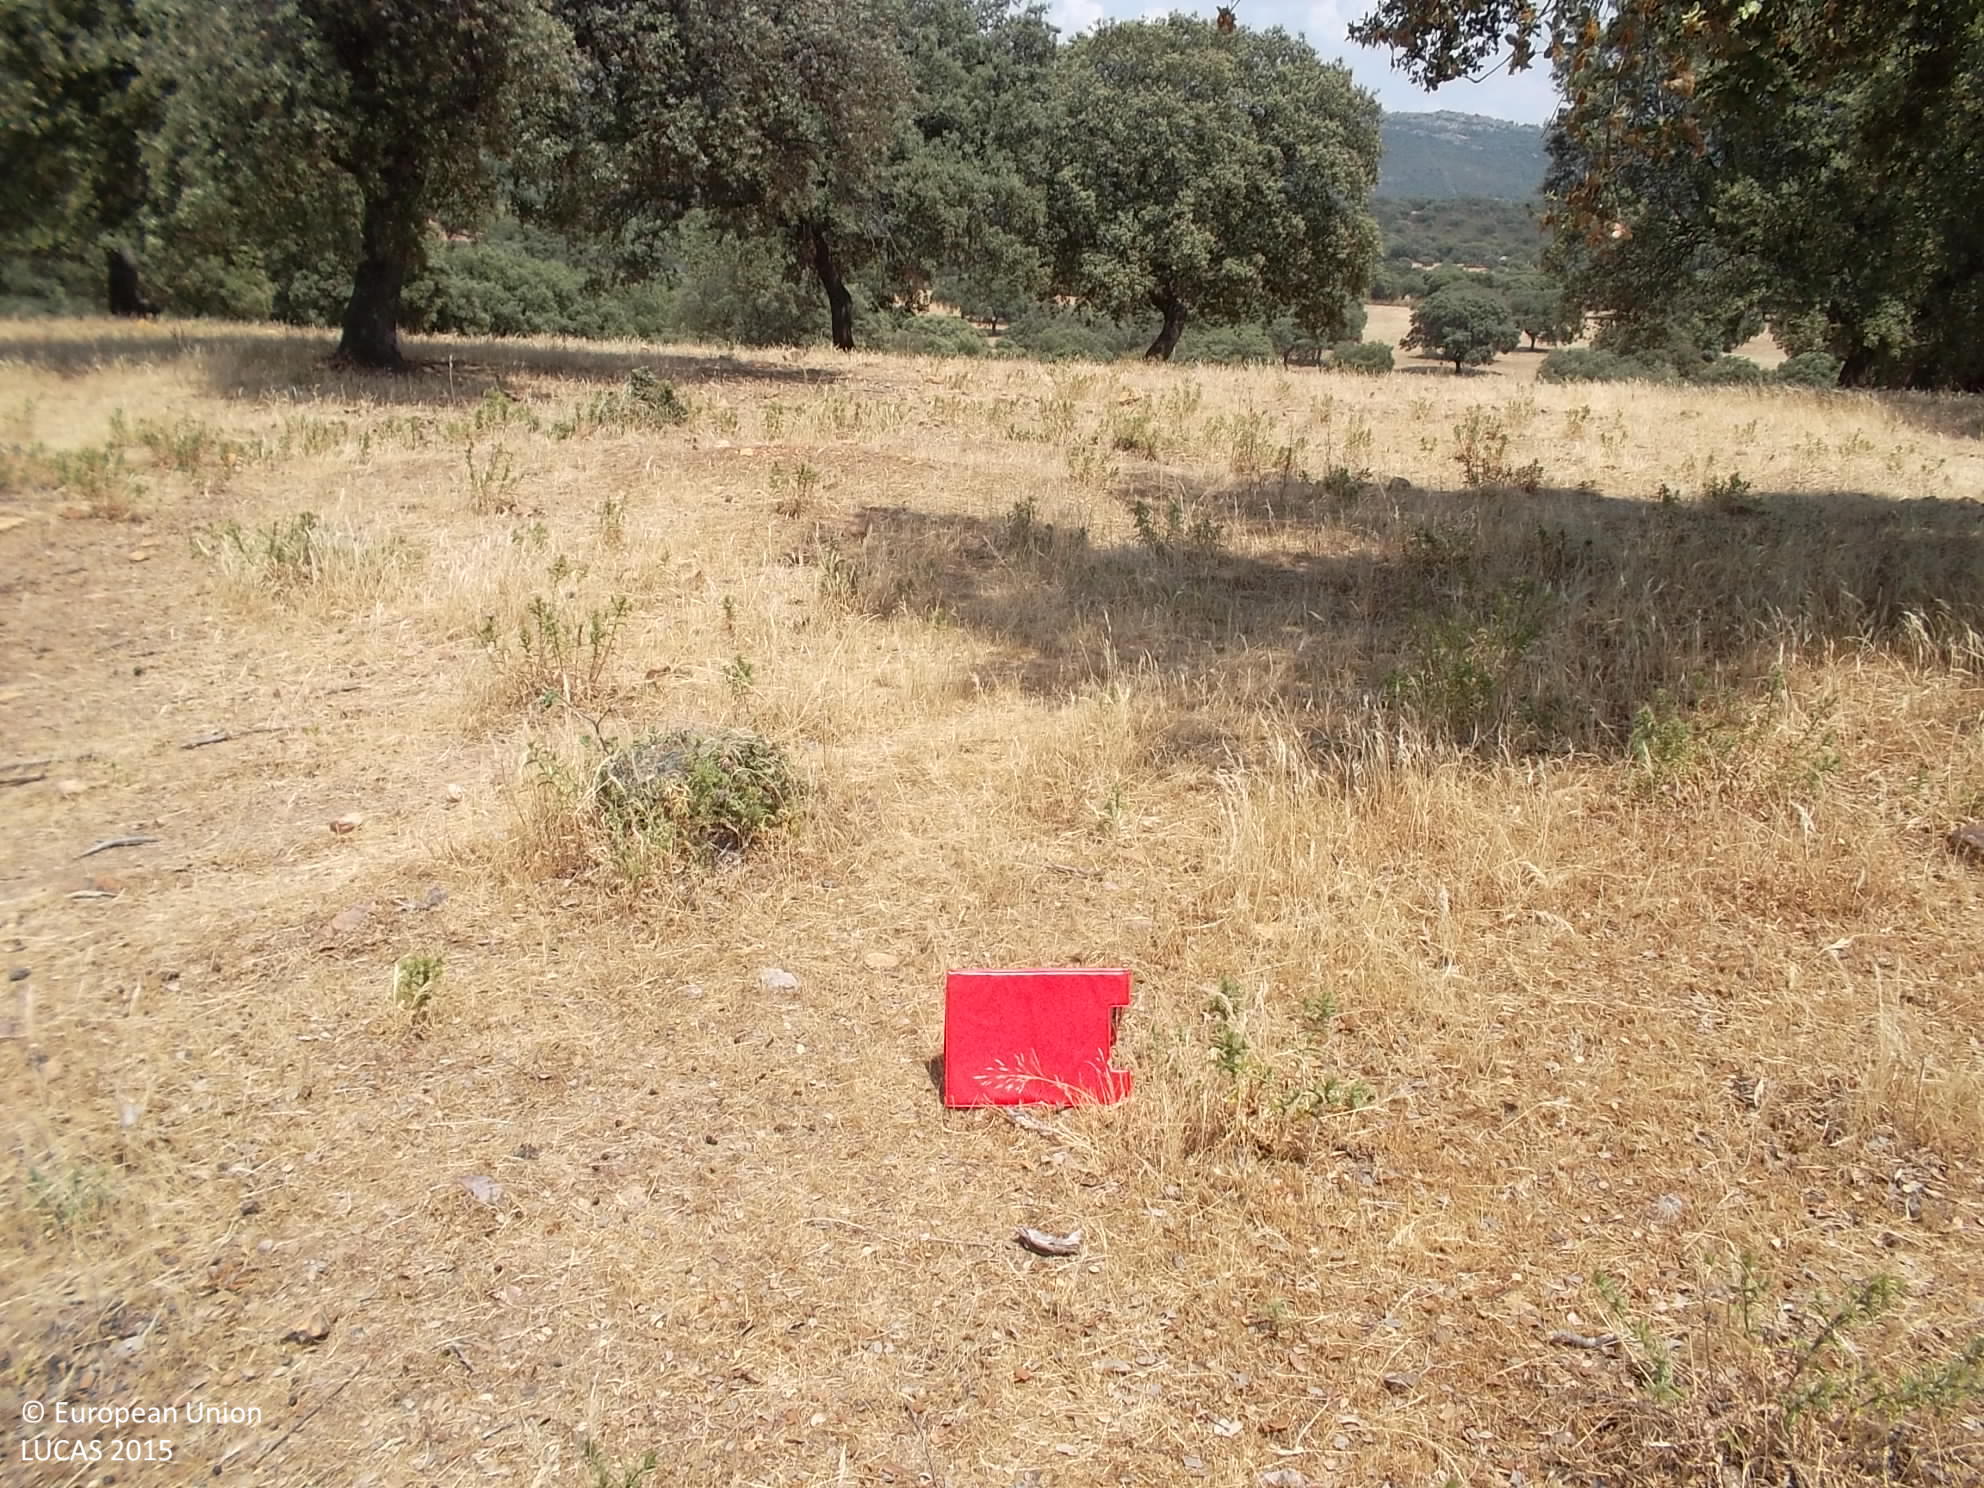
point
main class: Woodland
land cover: Broadleaved woodland
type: broadleaved evergreen forest
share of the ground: 25 - 50 %
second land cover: Spontaneously vegetated surfaces
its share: > 75 %
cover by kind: broadleaved forest trees 50 %, herbaceous plants 50 %
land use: Forestry
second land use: Agriculture (excluding fallow land and kitchen gardens)
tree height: > 5 m
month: June
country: ES
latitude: 39.1864
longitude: -4.9609
